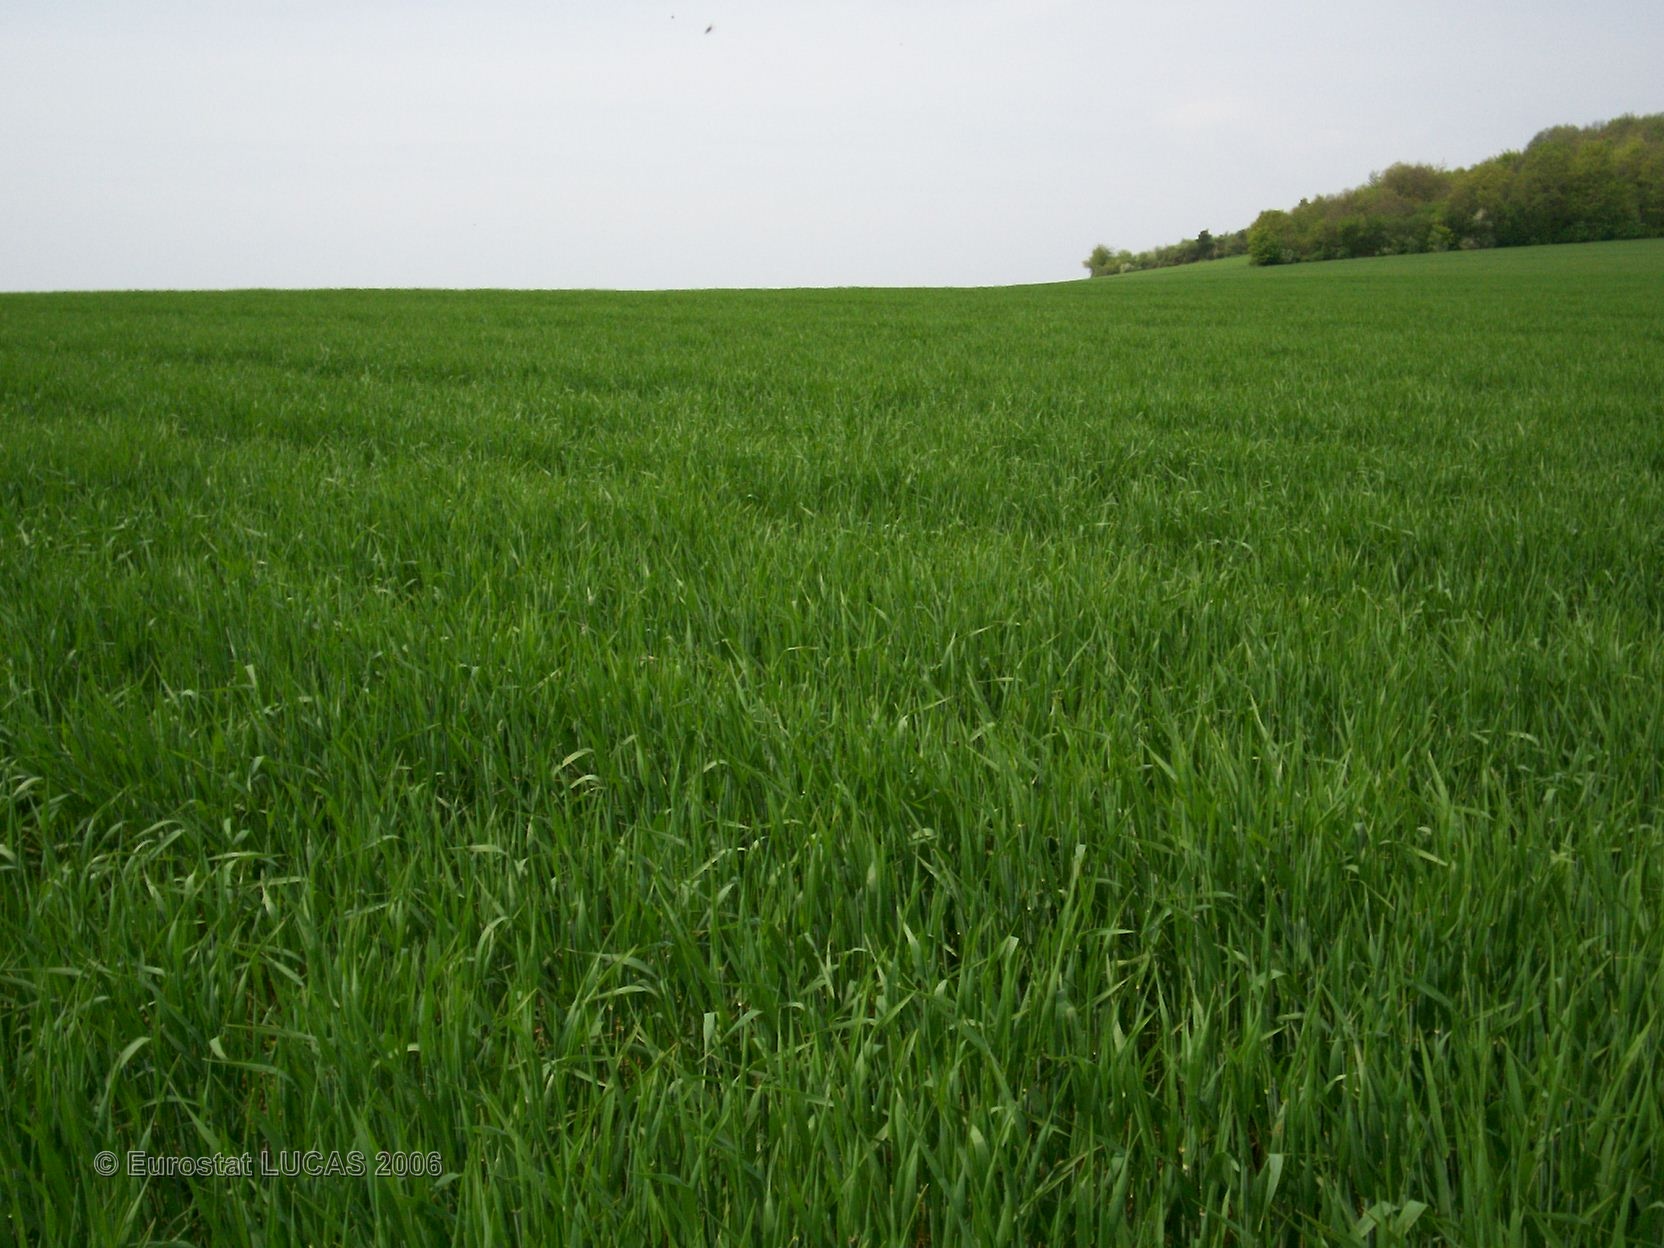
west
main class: Cropland
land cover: Barley
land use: Agriculture (excluding fallow land and kitchen gardens)
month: May
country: FR
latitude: 48.0855
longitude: 3.8071
